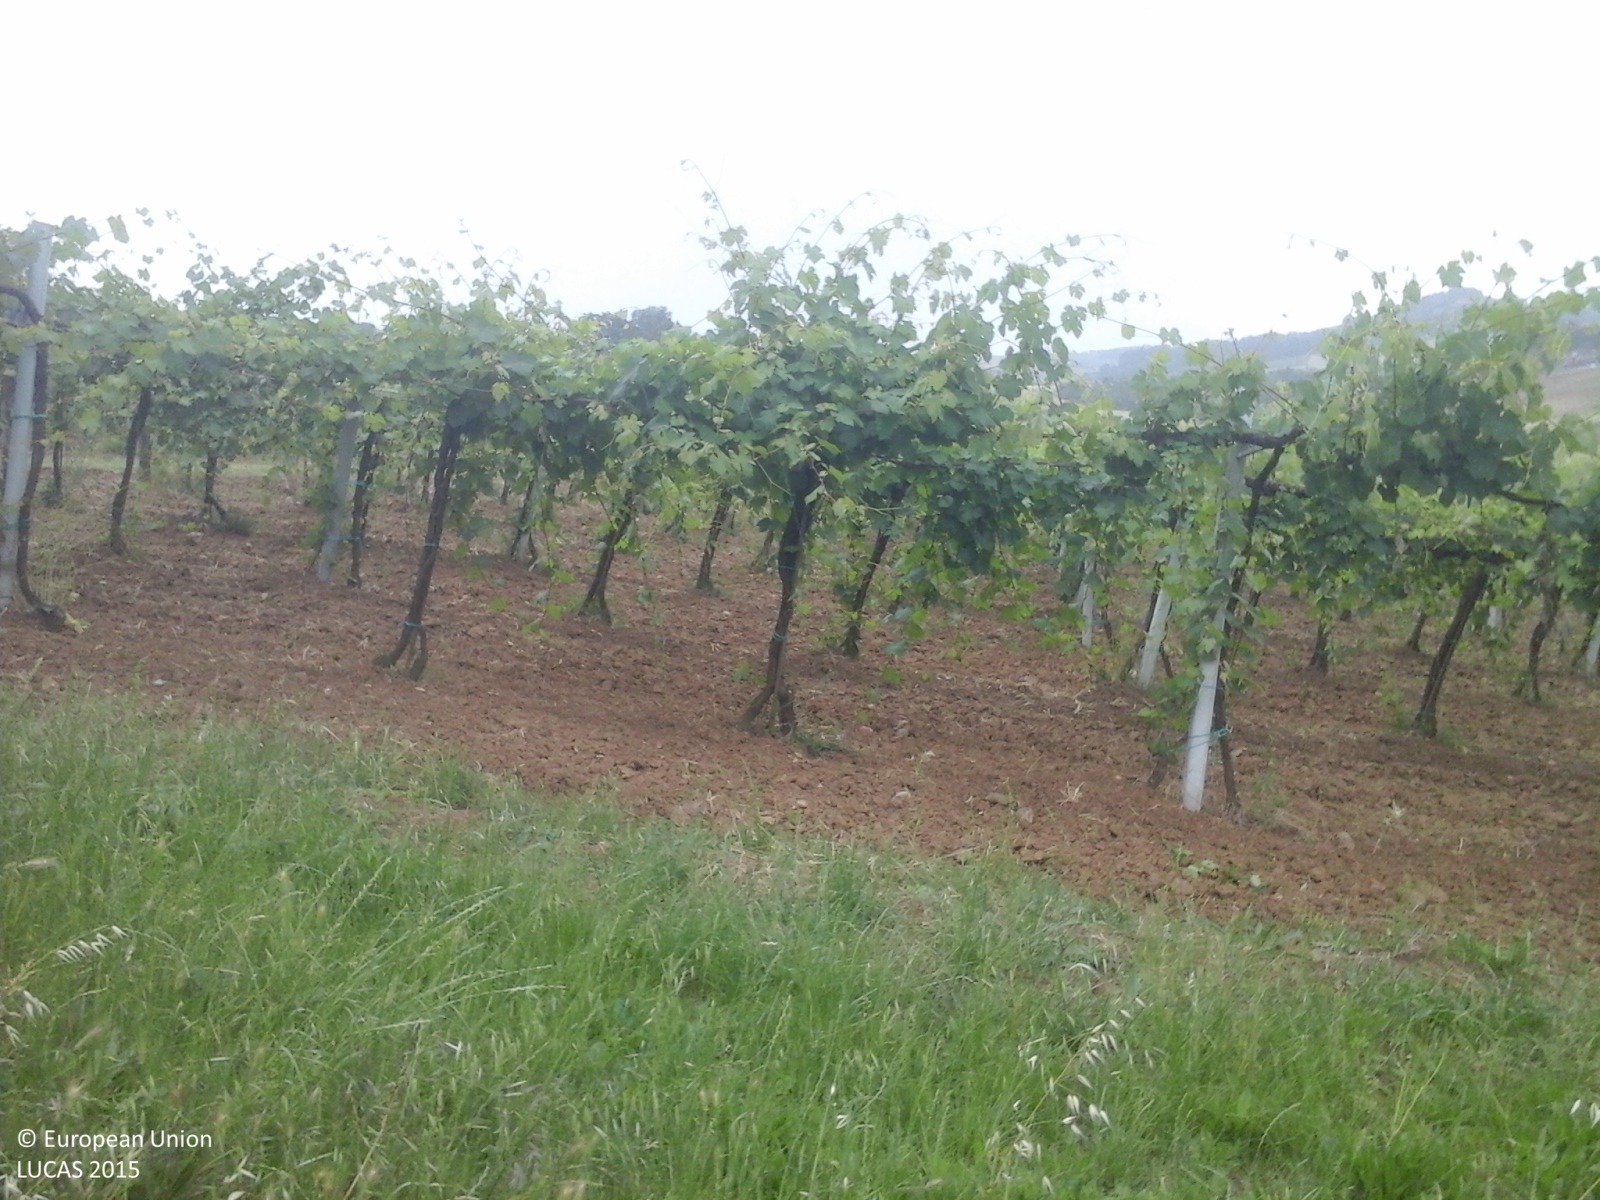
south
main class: Cropland
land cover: Lucerne
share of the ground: < 10 %
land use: Agriculture (excluding fallow land and kitchen gardens)
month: May
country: IT
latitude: 44.5084
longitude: 10.9664
